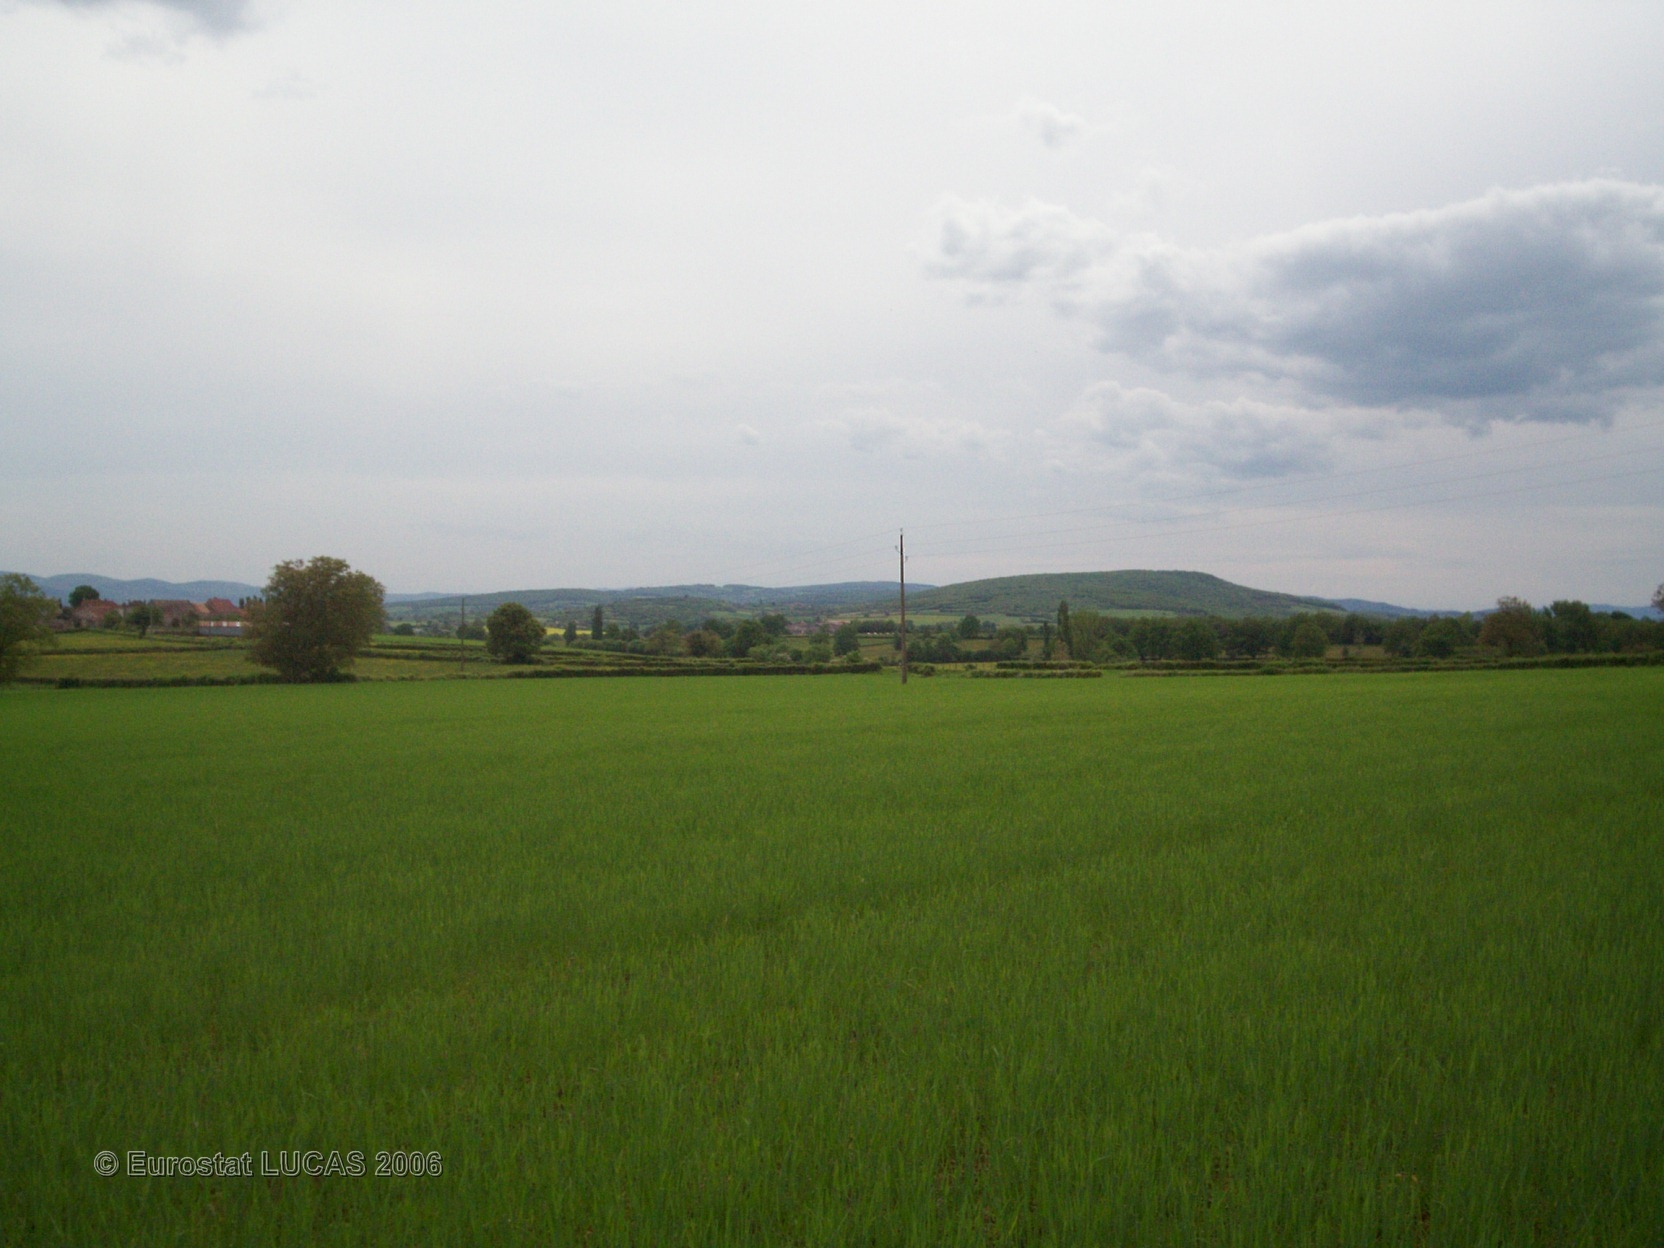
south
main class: Cropland
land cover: Barley
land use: Agriculture (excluding fallow land and kitchen gardens)
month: May
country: FR
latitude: 46.5598
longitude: 4.6401
